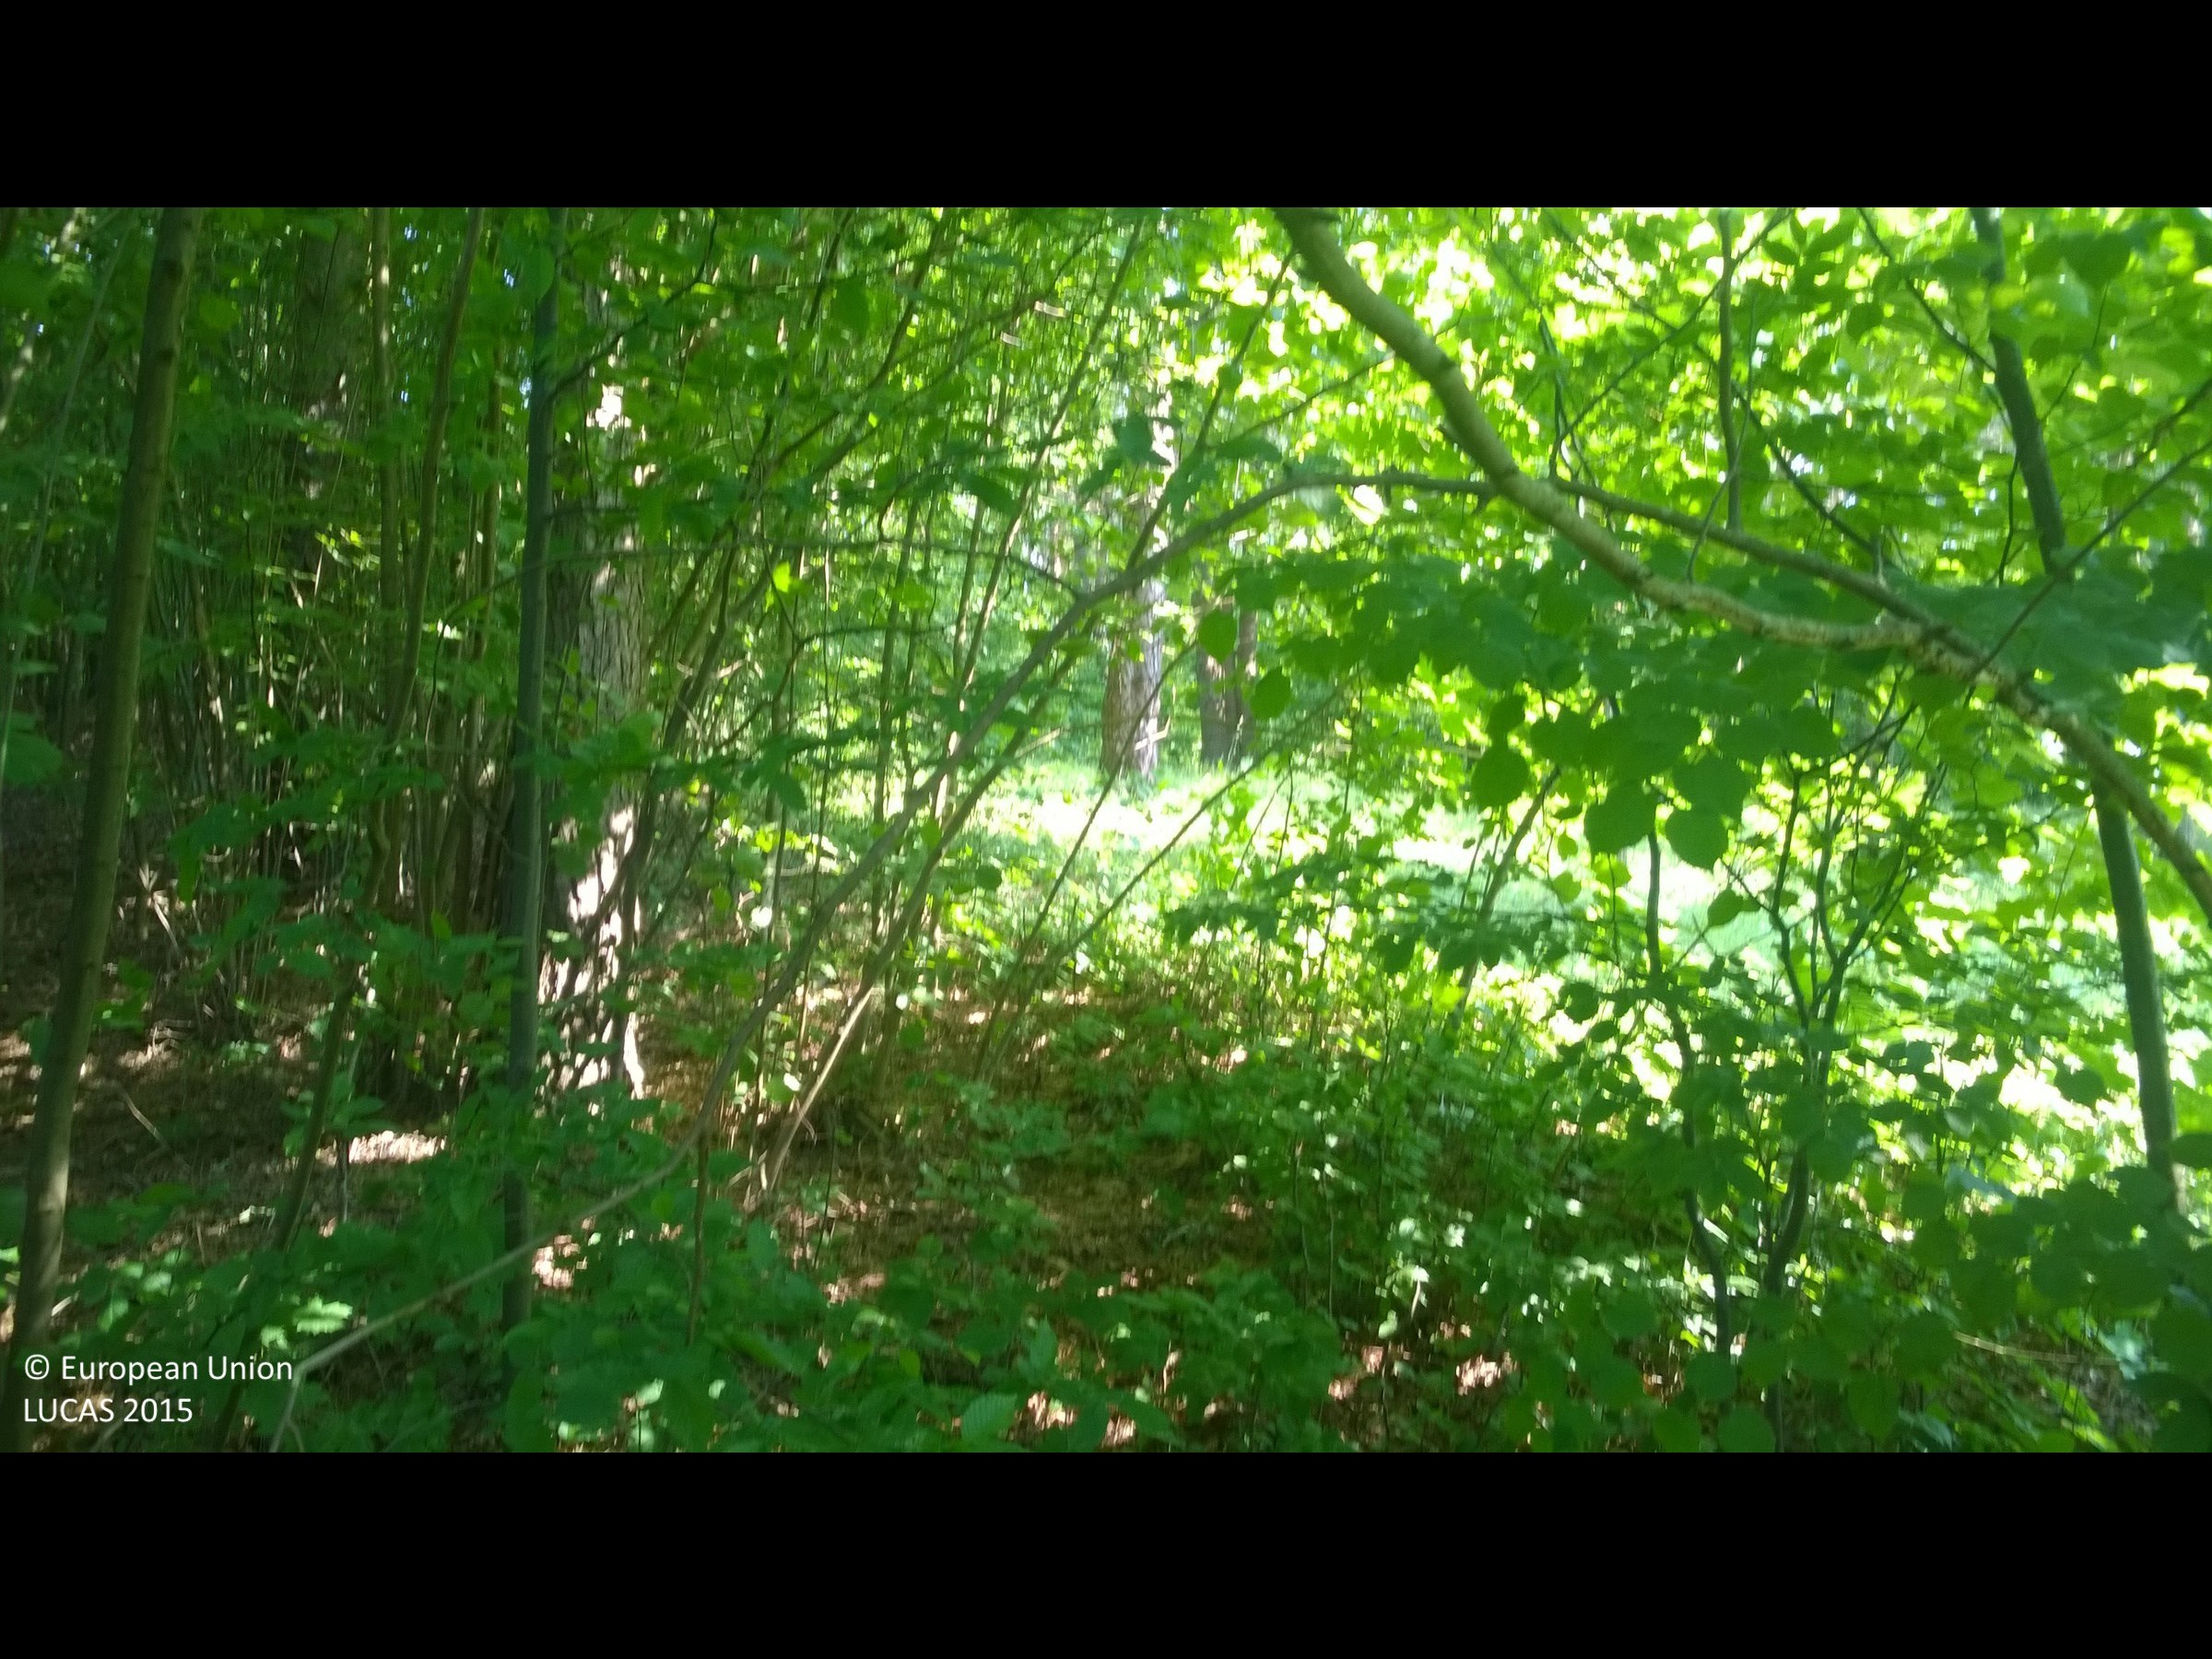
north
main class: Woodland
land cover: Pine dominated mixed woodland
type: hemiboreal forest and nemoral coniferous forest and mixed broadleaved-coniferous forest
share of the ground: > 75 %
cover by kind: coniferous forest trees 50 %, broadleaved forest trees 35 %, shrubs 10 %, herbaceous plants 5 %
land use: Forestry
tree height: > 5 m
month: June
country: PL
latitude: 53.1096
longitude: 23.3921
